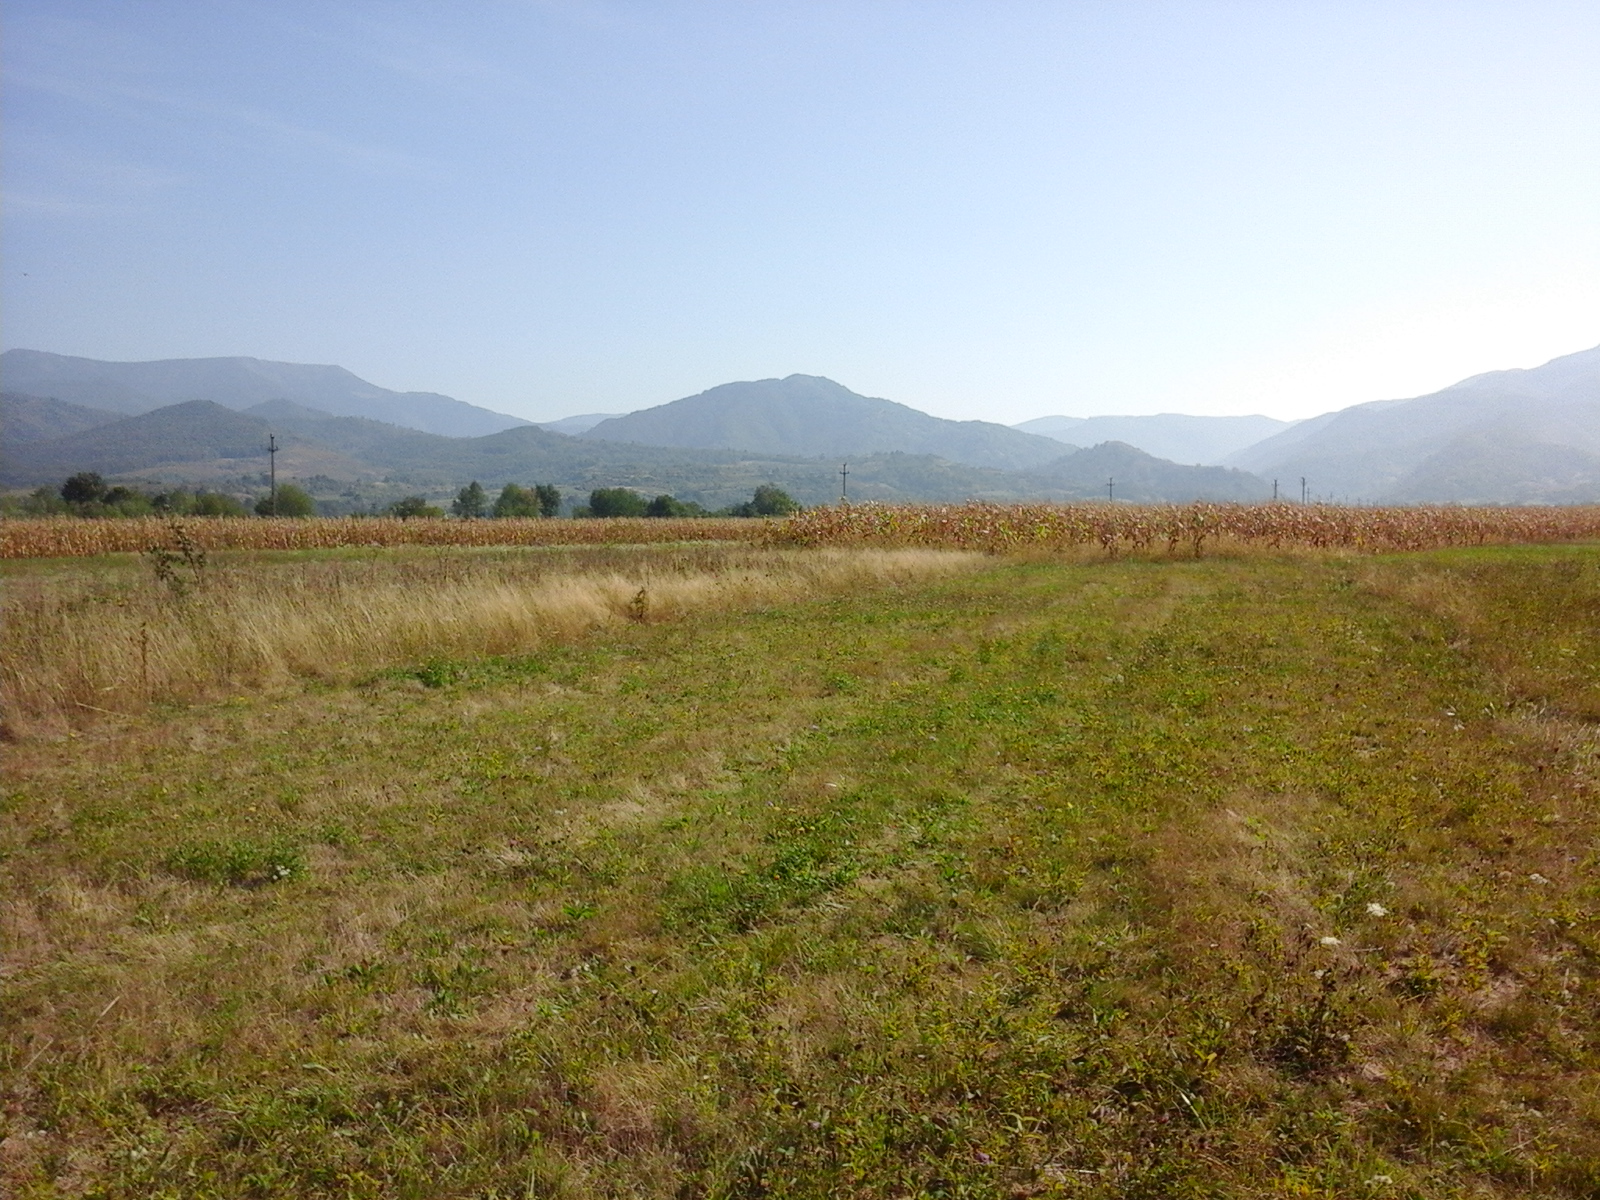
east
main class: Grassland
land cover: Grassland without tree/shrub cover
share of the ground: > 75 %
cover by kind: herbaceous plants 100 %
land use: Agriculture (excluding fallow land and kitchen gardens)
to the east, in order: Grassland without tree/shrub cover; Tracks; Grass margins; Maize; Grassland without tree/shrub cover; Maize; Grass margins; Tracks; Grassland without tree/shrub cover
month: September
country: RO
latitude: 46.5961
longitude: 22.5181
